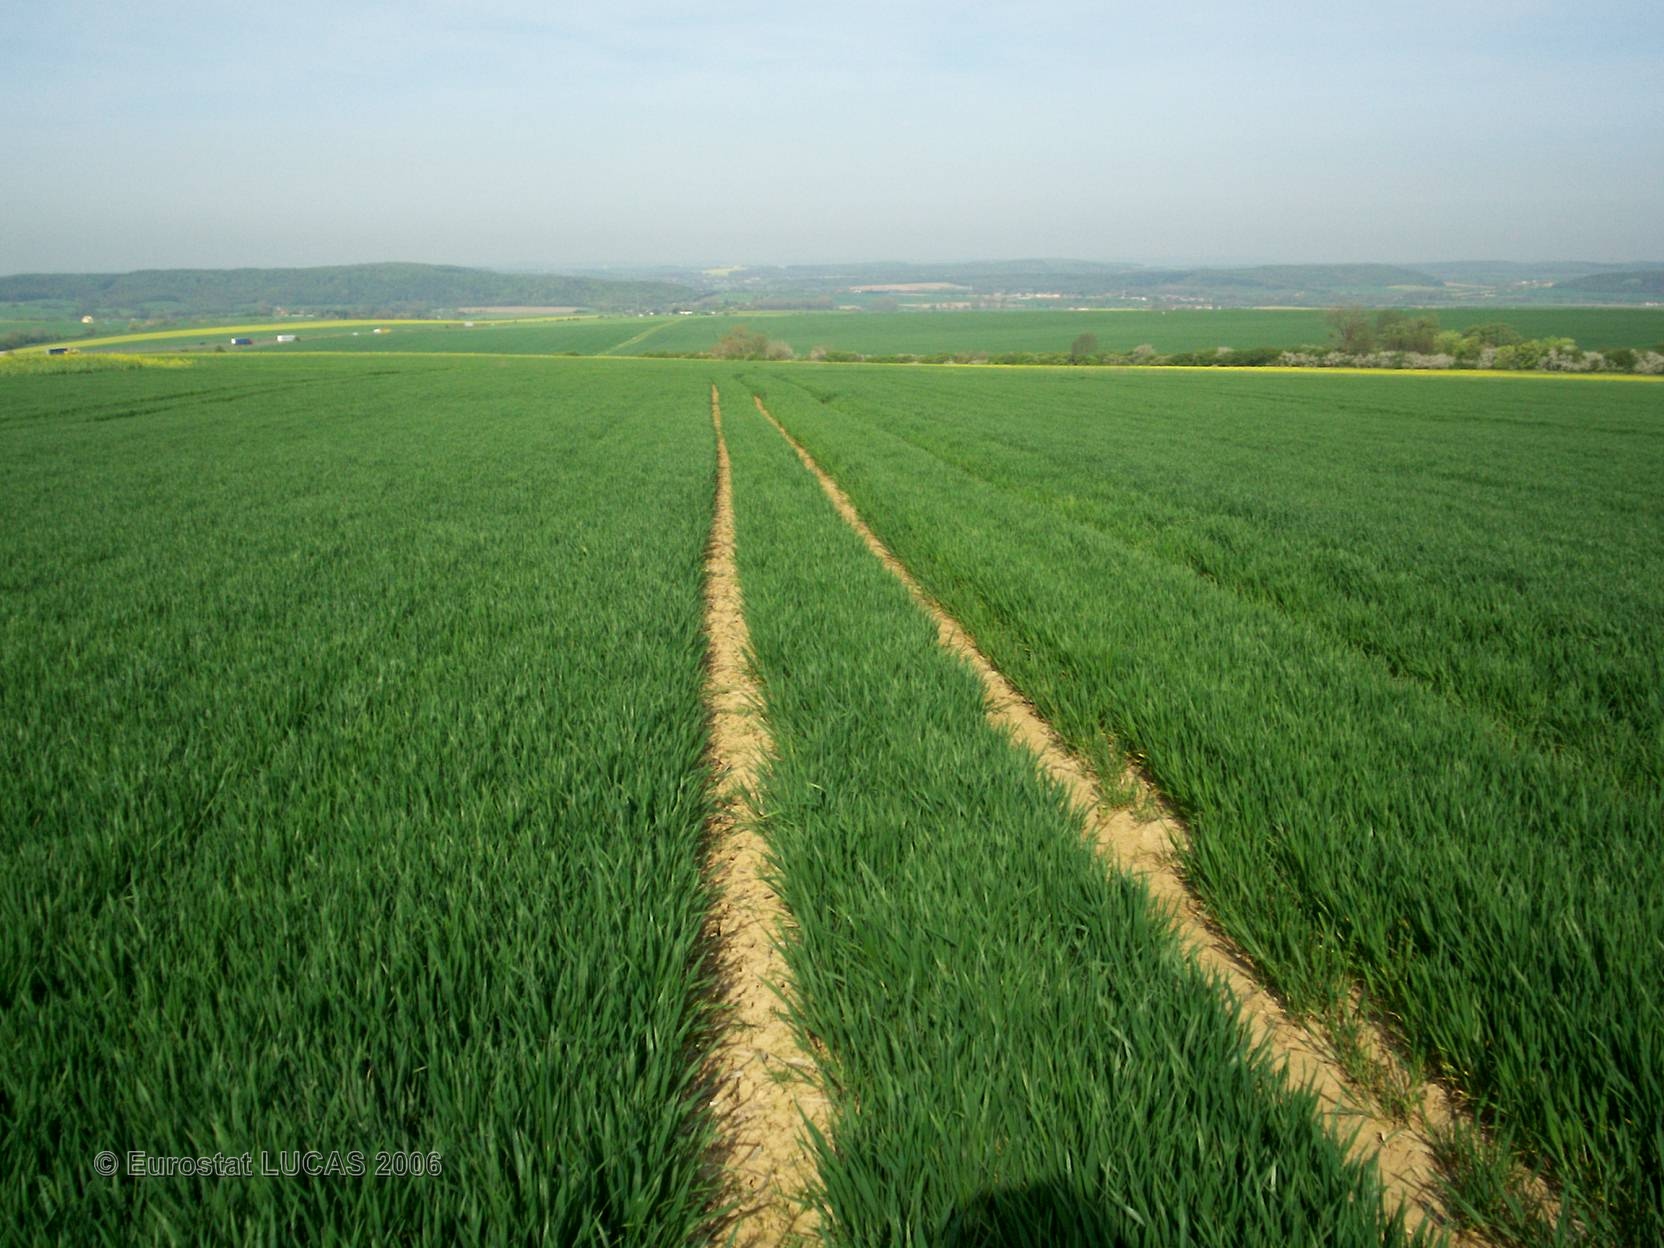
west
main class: Cropland
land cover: Common wheat
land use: Agriculture (excluding fallow land and kitchen gardens)
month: May
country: FR
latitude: 49.1406
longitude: 6.5046
